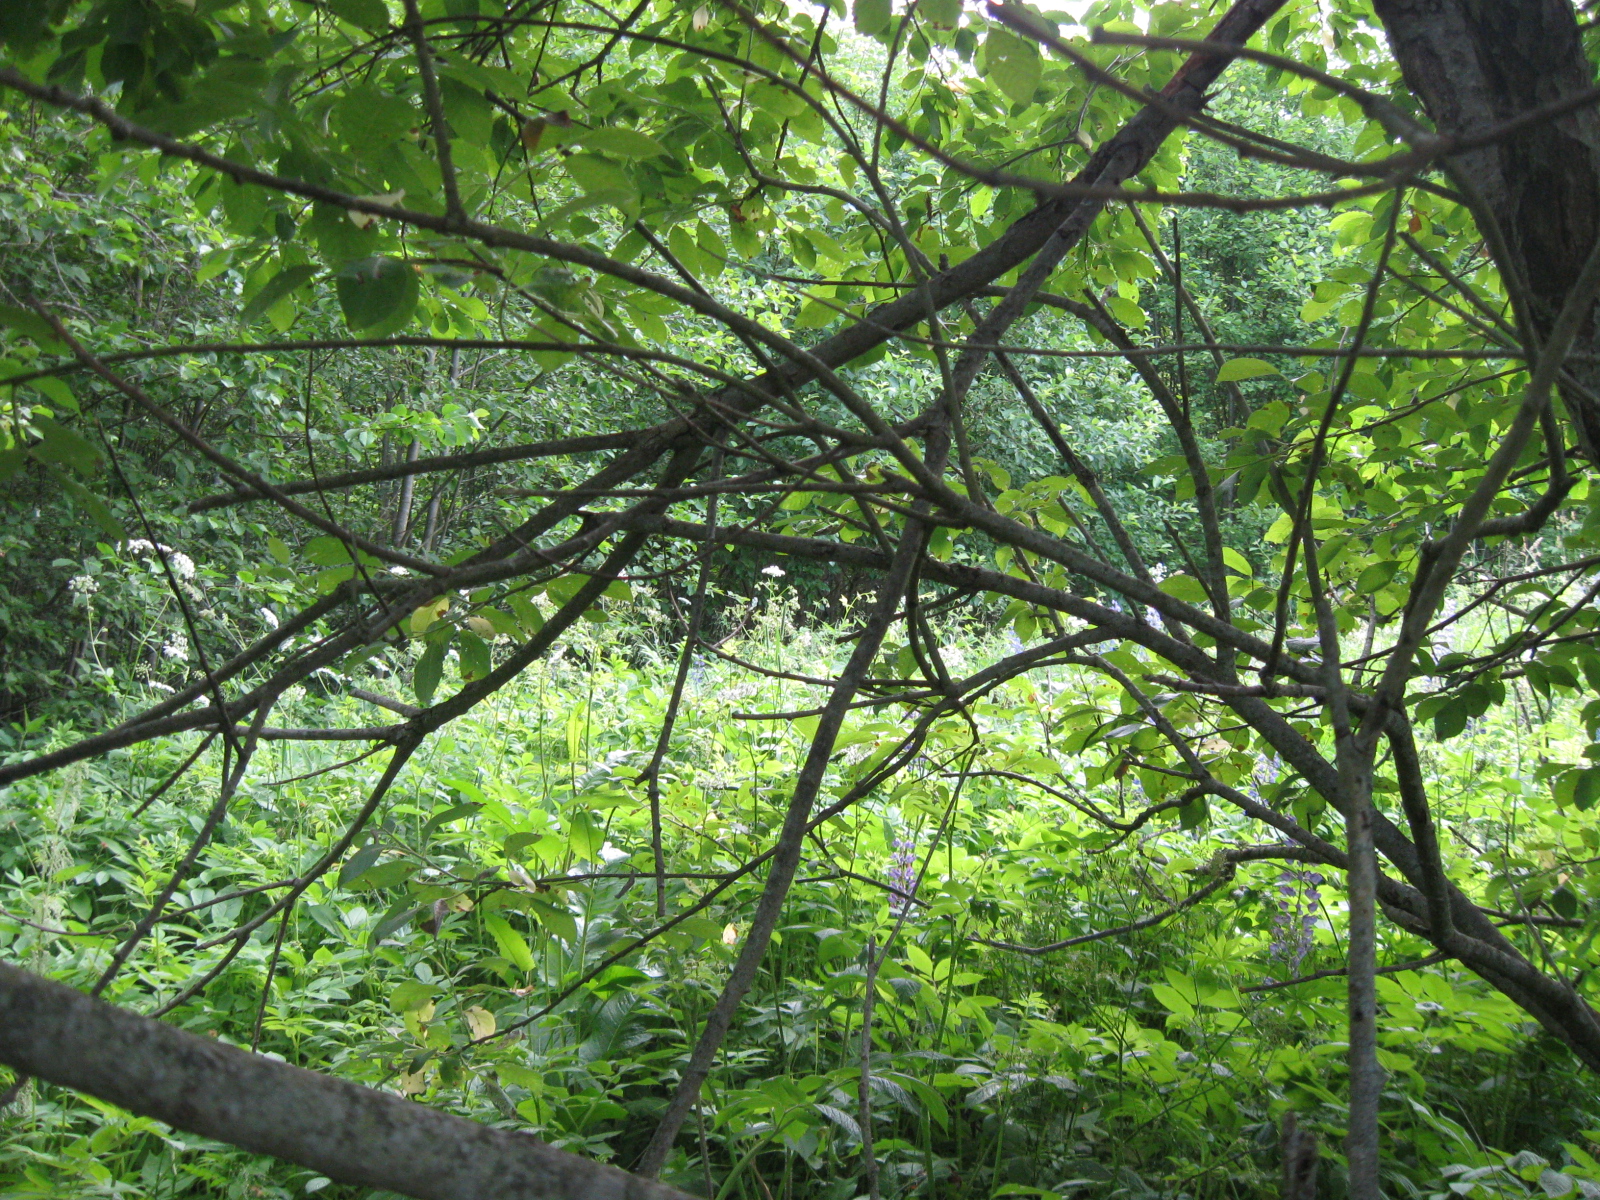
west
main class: Woodland
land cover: Broadleaved woodland
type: floodplain forest
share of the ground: 50 - 75 %
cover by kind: broadleaved forest trees 70 %, herbaceous plants 30 %
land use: Forestry
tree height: > 5 m
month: June
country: LT
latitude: 54.4334
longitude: 24.5810
